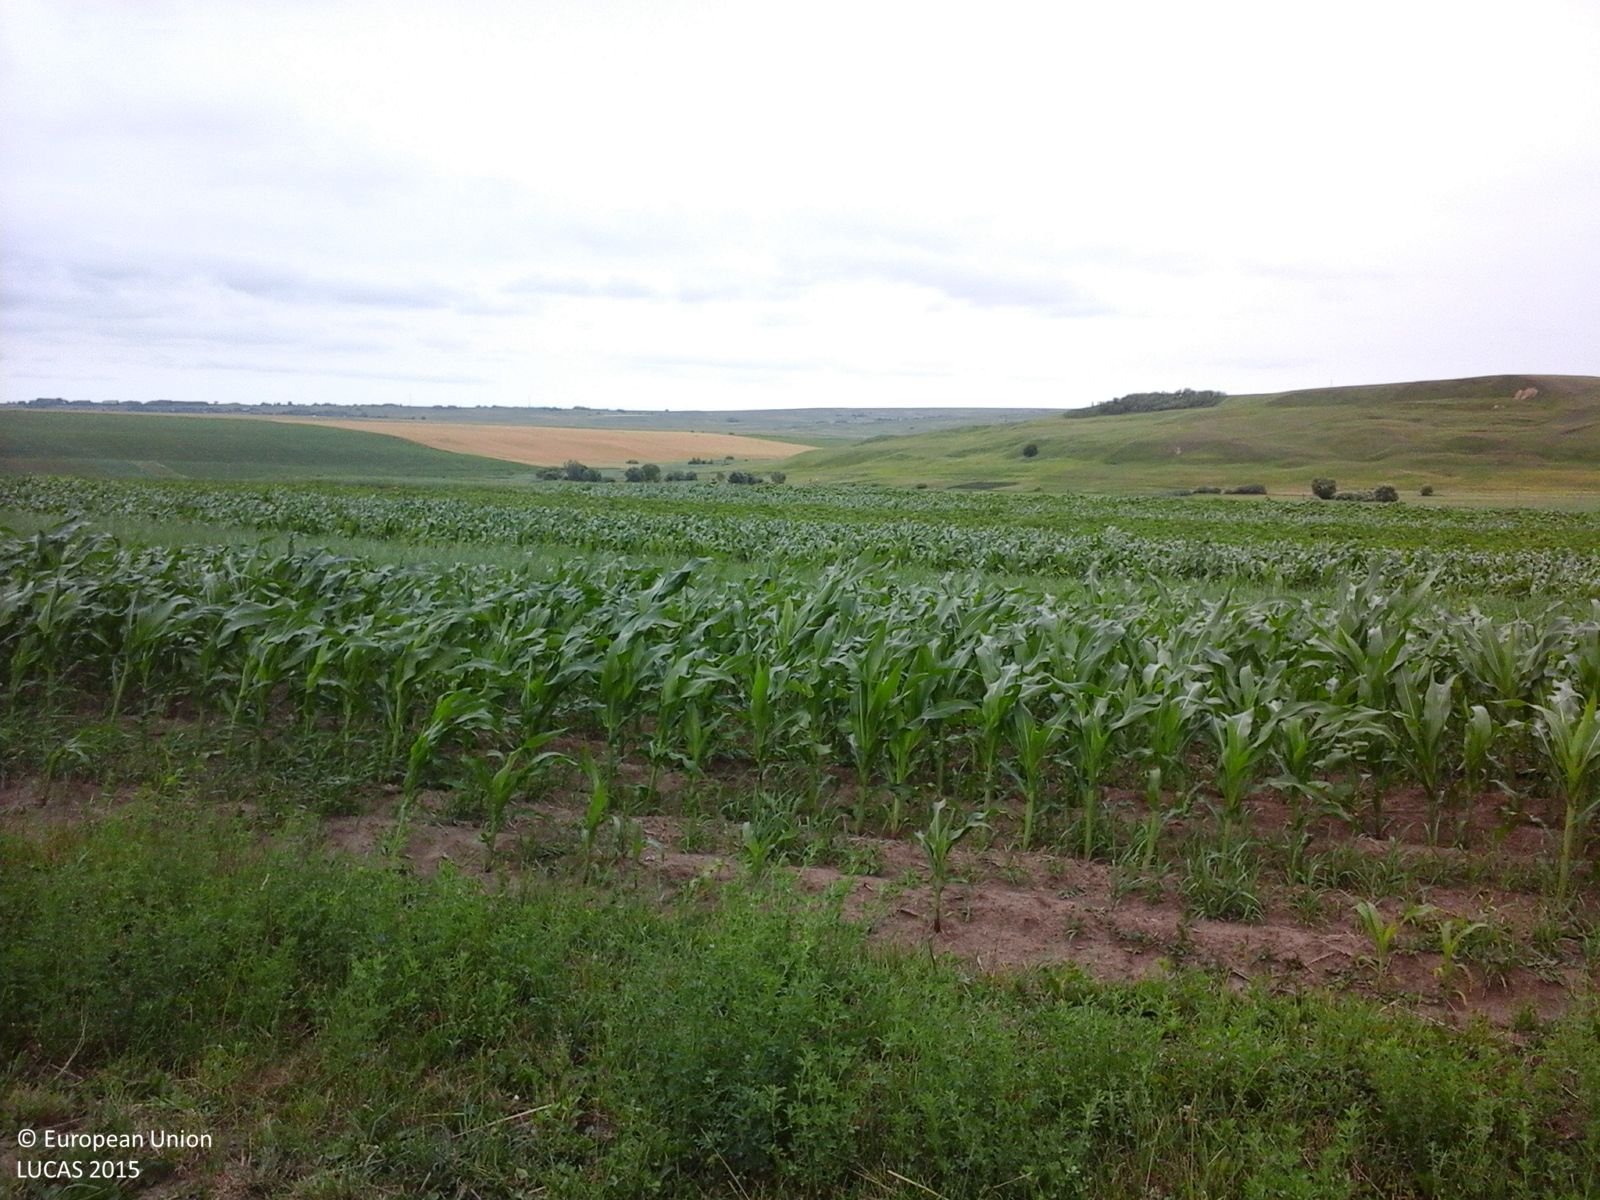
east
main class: Cropland
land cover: Lucerne
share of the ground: > 75 %
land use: Agriculture (excluding fallow land and kitchen gardens)
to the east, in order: Lucerne; Maize; Oats; Maize; Sunflower; Maize; Tracks; Grassland without tree/shrub cover; Ditches and canals; Grass margins; Tracks; Grass margins; Ditches and canals; Grassland without tree/shrub cover; Maize; Oats; Grassland without tree/shrub cover; Maize; Lucerne
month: June
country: RO
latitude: 48.0856
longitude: 26.4009
